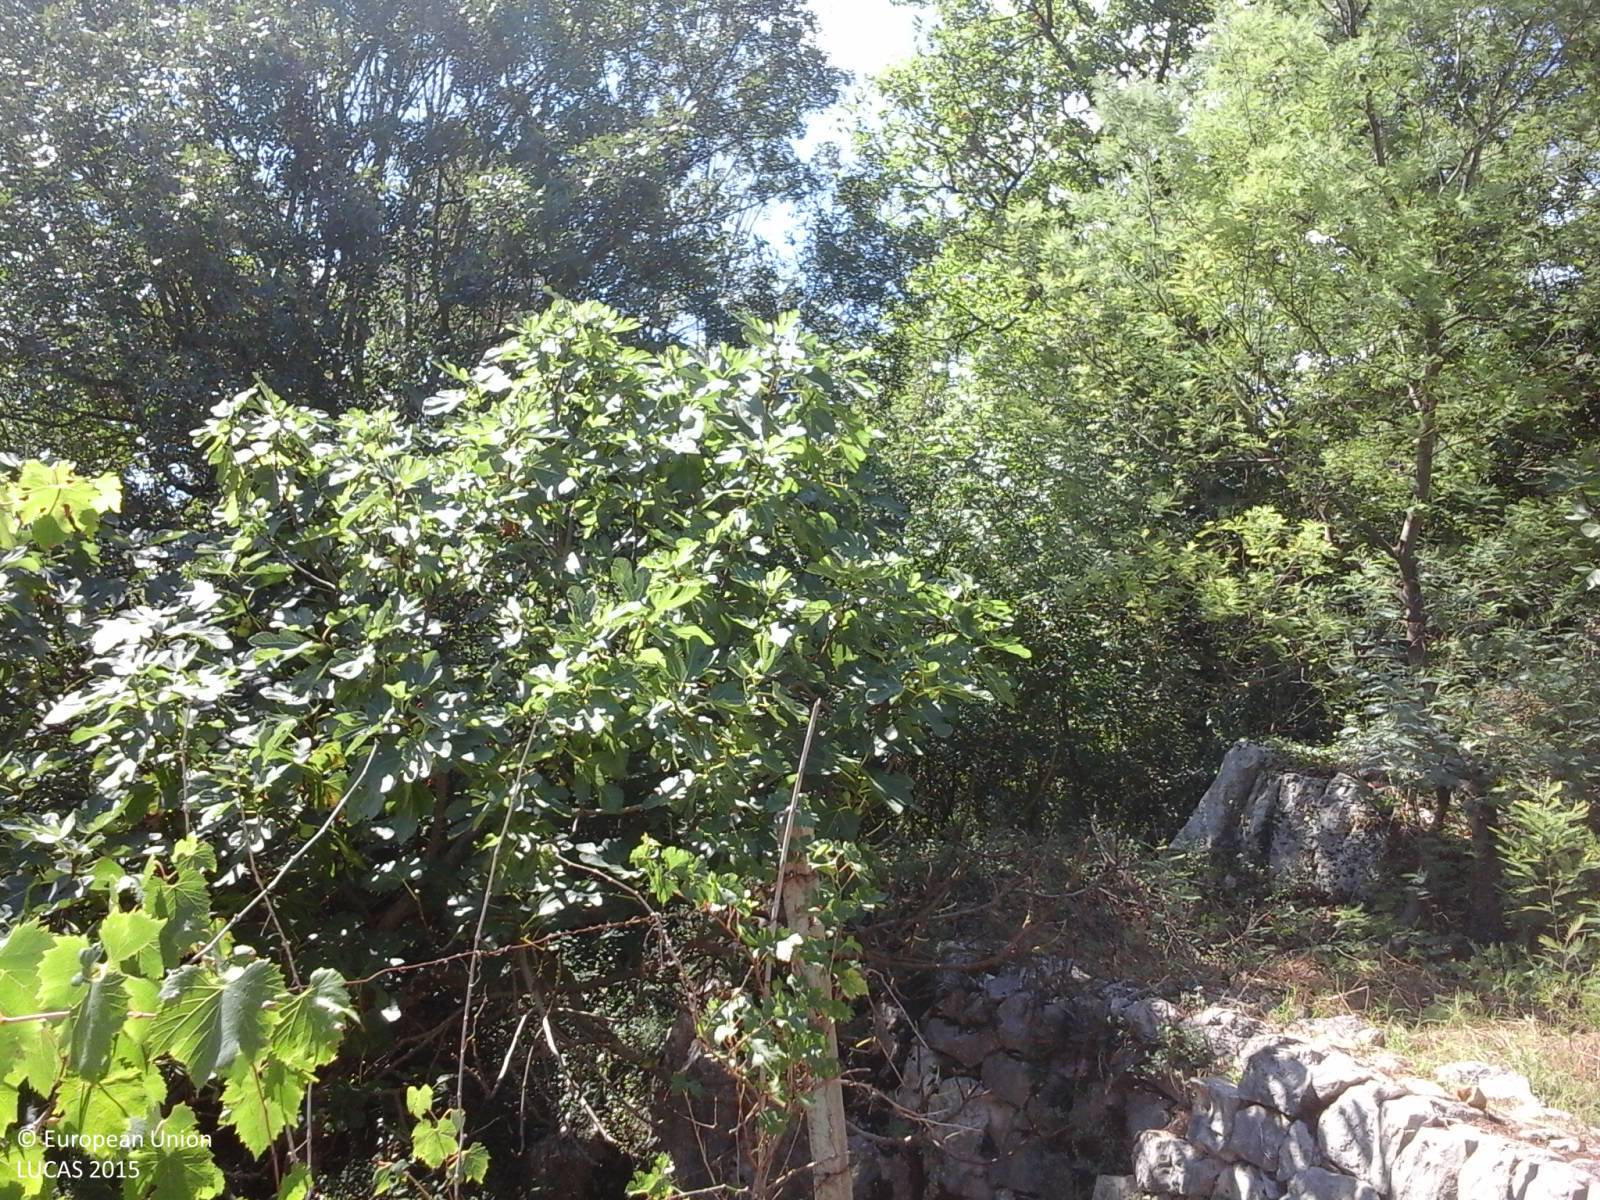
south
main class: Cropland
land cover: Vineyards
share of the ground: 25 - 50 %
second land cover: Spontaneously vegetated surfaces
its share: > 75 %
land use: Agriculture (excluding fallow land and kitchen gardens)
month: August
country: IT
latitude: 41.4577
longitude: 13.3987
